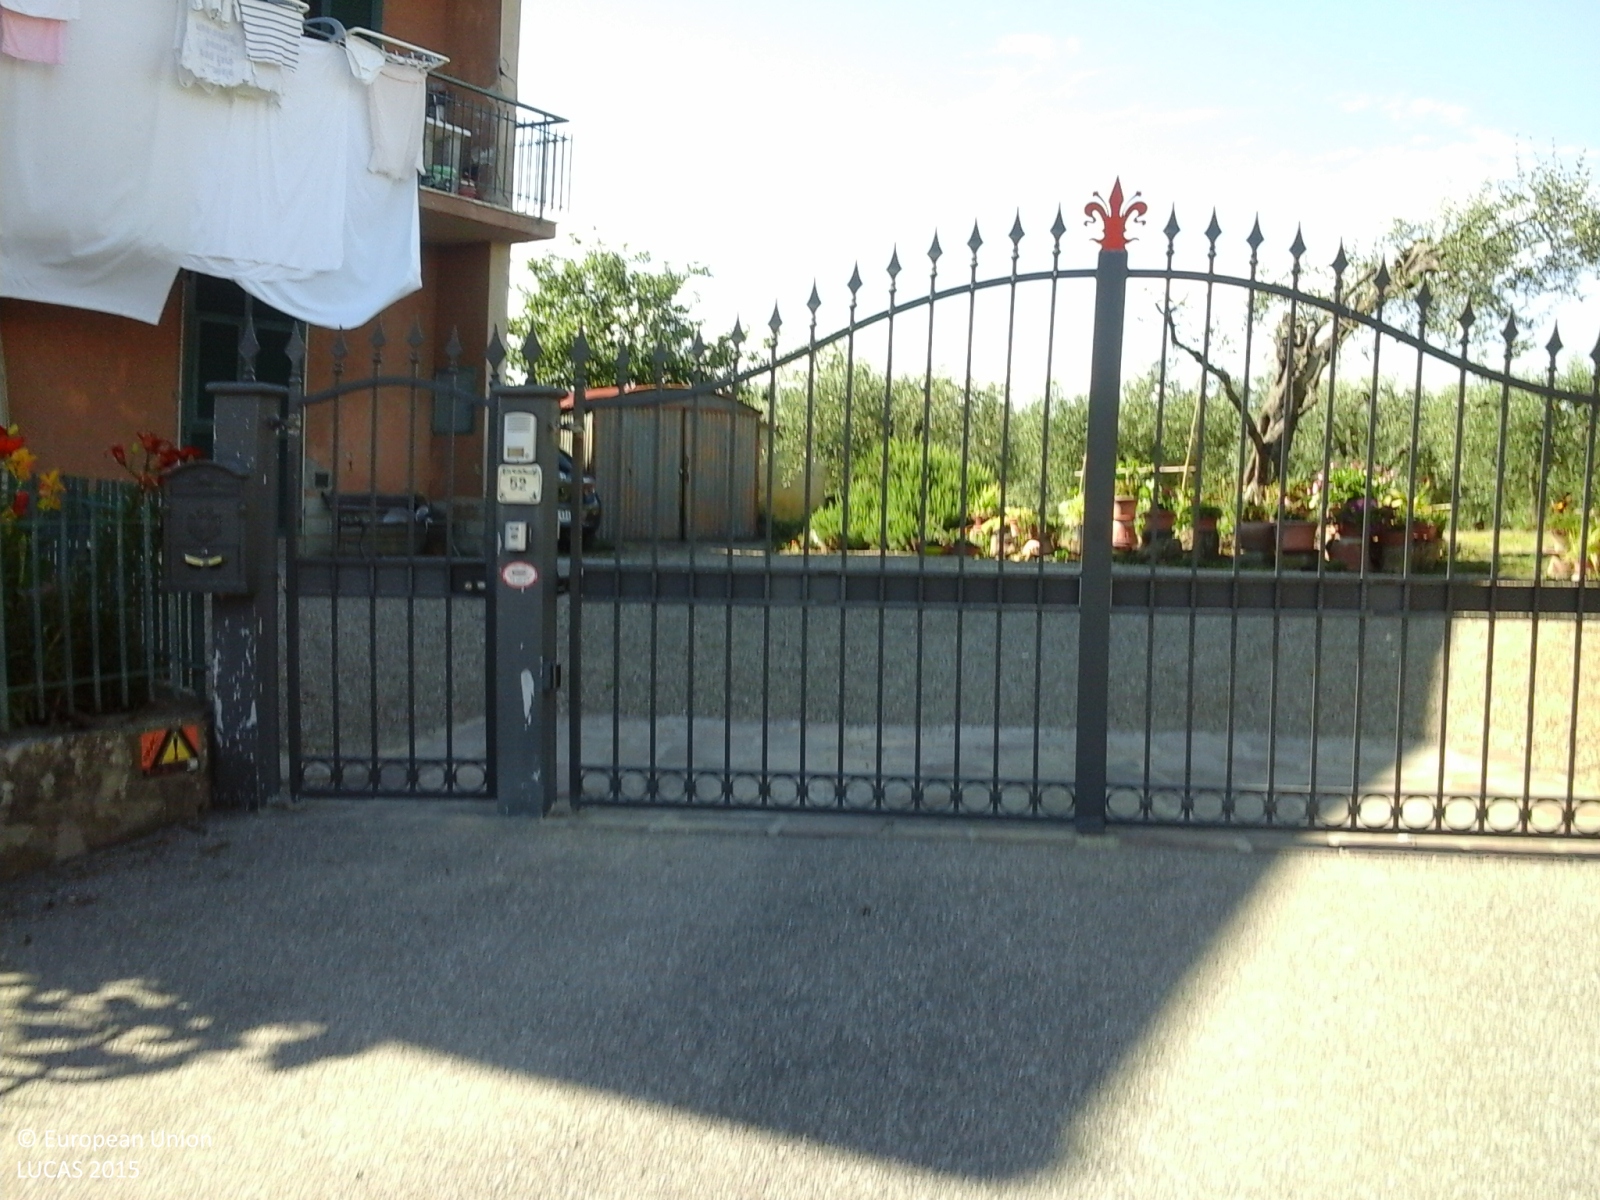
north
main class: Cropland
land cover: Olive groves
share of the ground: > 75 %
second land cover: Grassland without tree/shrub cover
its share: > 75 %
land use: Agriculture (excluding fallow land and kitchen gardens)
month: June
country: IT
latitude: 43.7496
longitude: 11.0776
